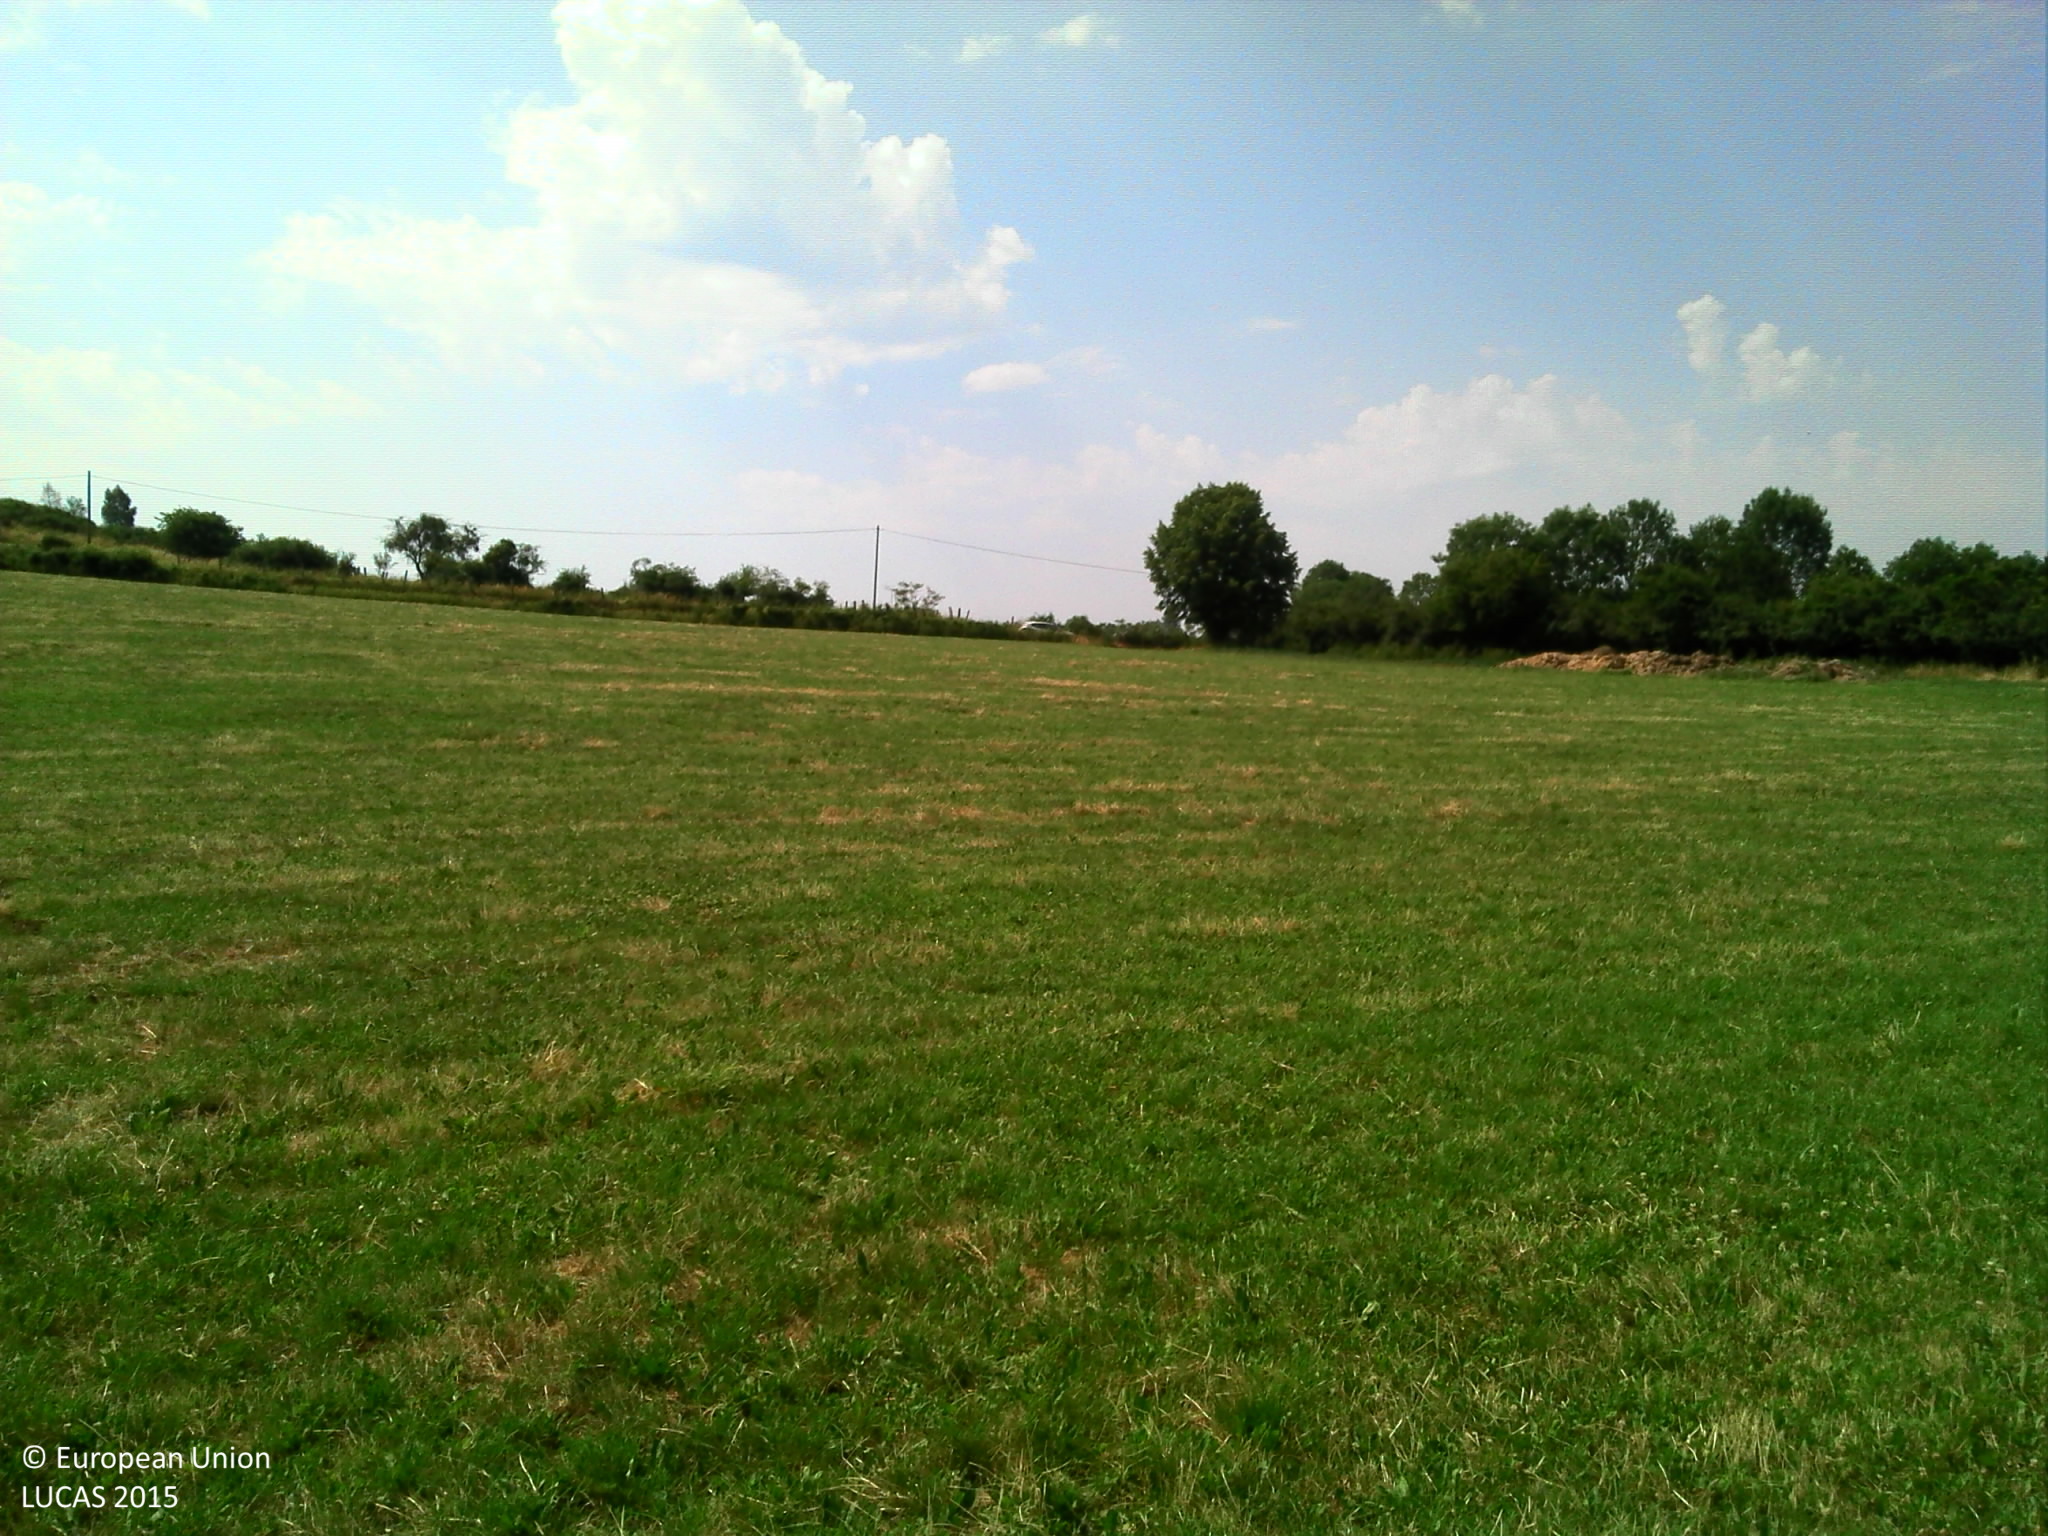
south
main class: Grassland
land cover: Grassland without tree/shrub cover
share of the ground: > 75 %
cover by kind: herbaceous plants 100 %
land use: Agriculture (excluding fallow land and kitchen gardens)
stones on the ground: < 10 %
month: July
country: FR
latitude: 44.8691
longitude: 2.9271
